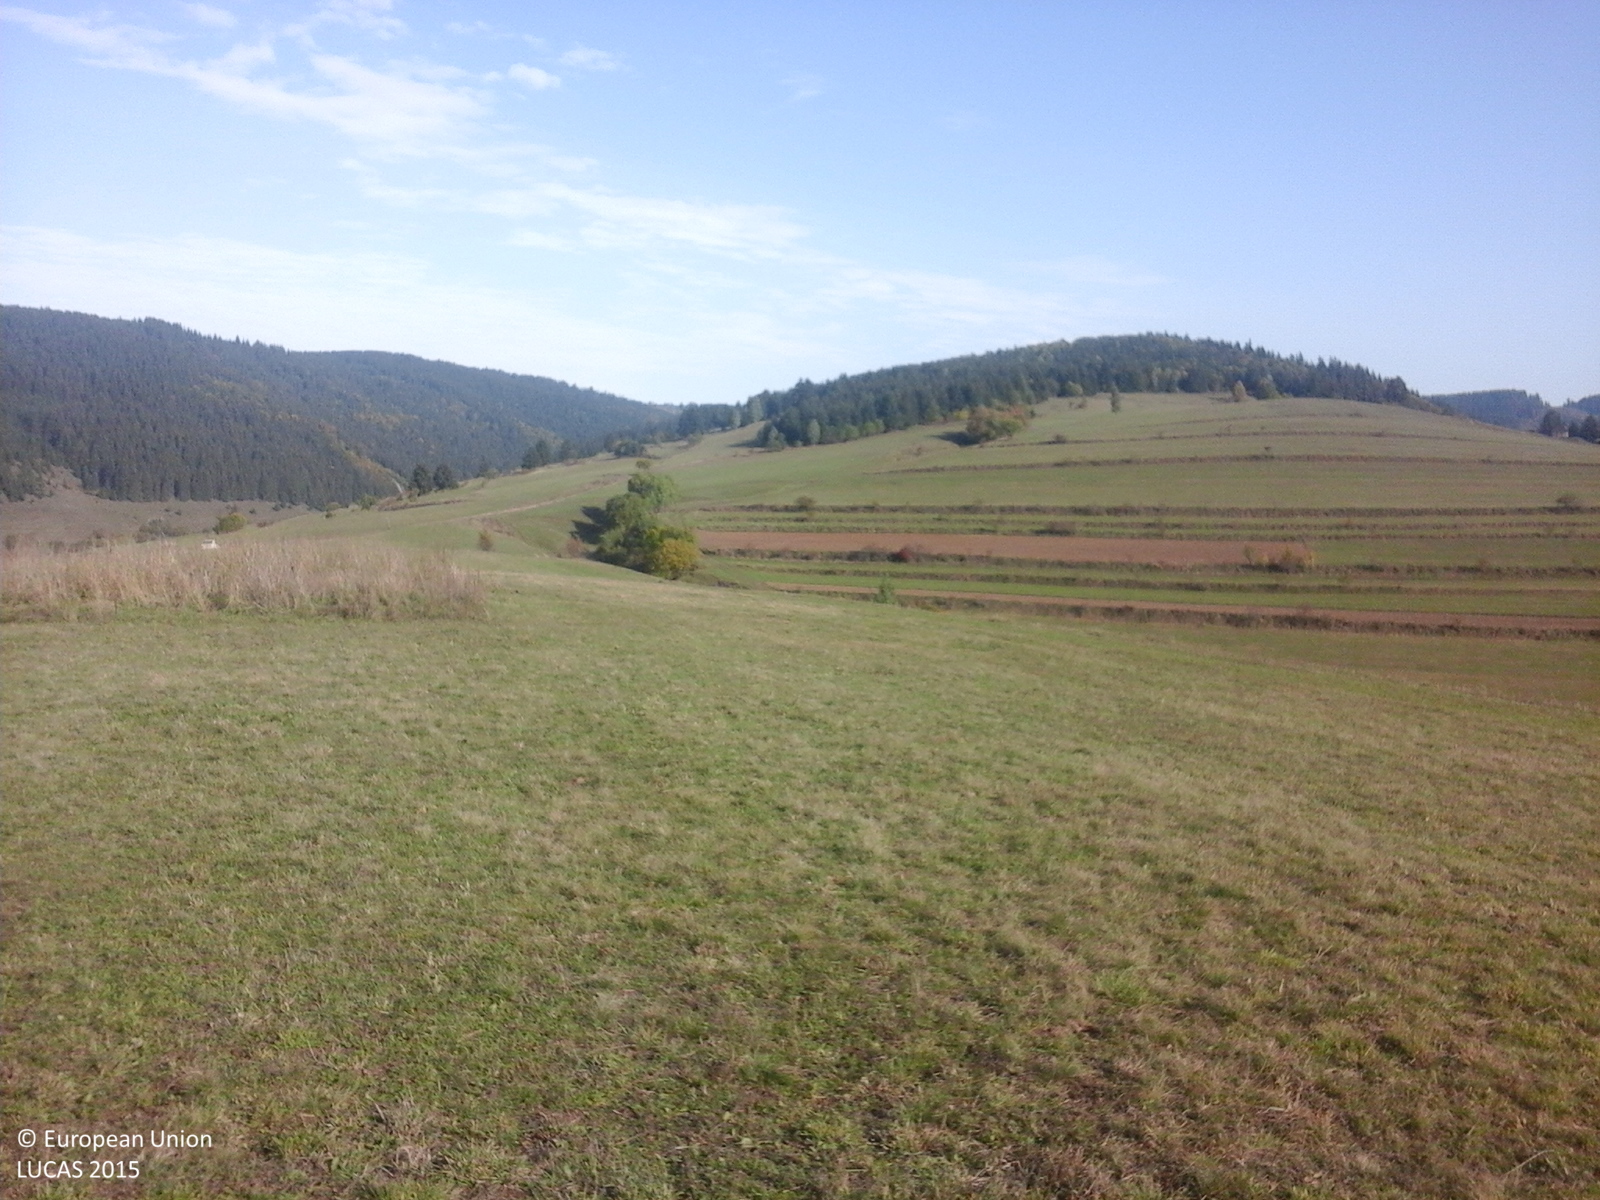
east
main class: Grassland
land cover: Grassland without tree/shrub cover
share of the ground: > 75 %
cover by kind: herbaceous plants 100 %
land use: Agriculture (excluding fallow land and kitchen gardens)
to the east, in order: Grassland without tree/shrub cover; Tracks; Grassland without tree/shrub cover
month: October
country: RO
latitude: 46.3867
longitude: 25.8637
